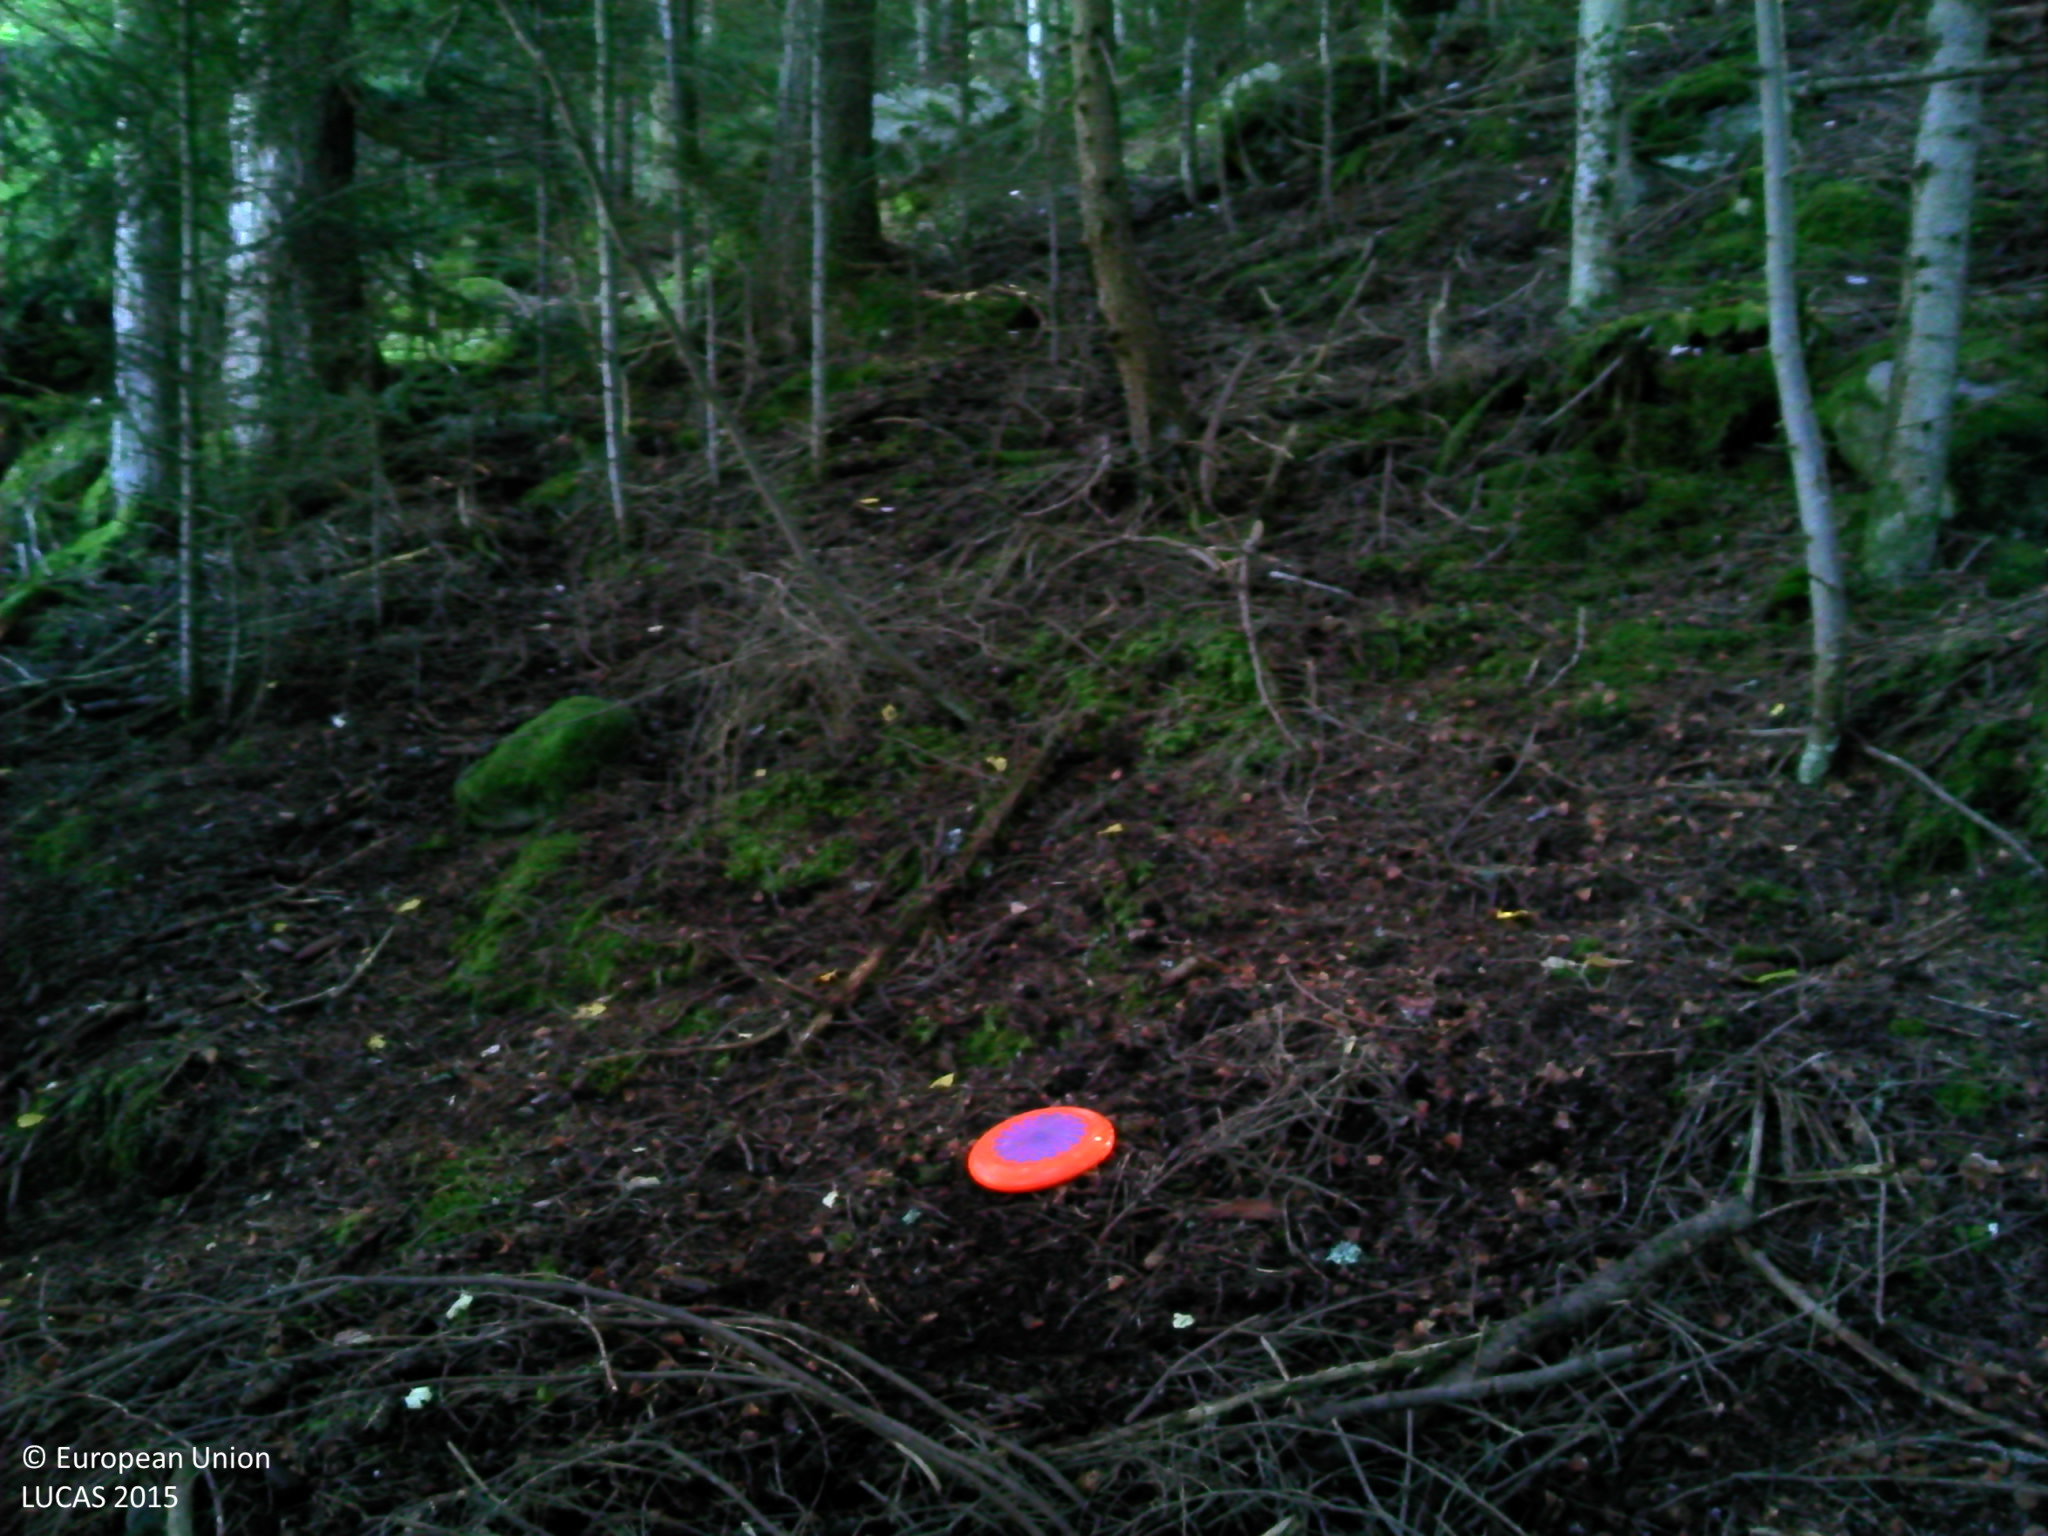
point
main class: Woodland
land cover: Spruce dominated coniferous woodland
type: alpine coniferous forest
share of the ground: > 75 %
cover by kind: coniferous forest trees 95 %, consolidated bare surface 5 %
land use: Forestry
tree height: > 5 m
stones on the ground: < 10 %
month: October
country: FR
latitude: 45.3337
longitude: 6.3683
